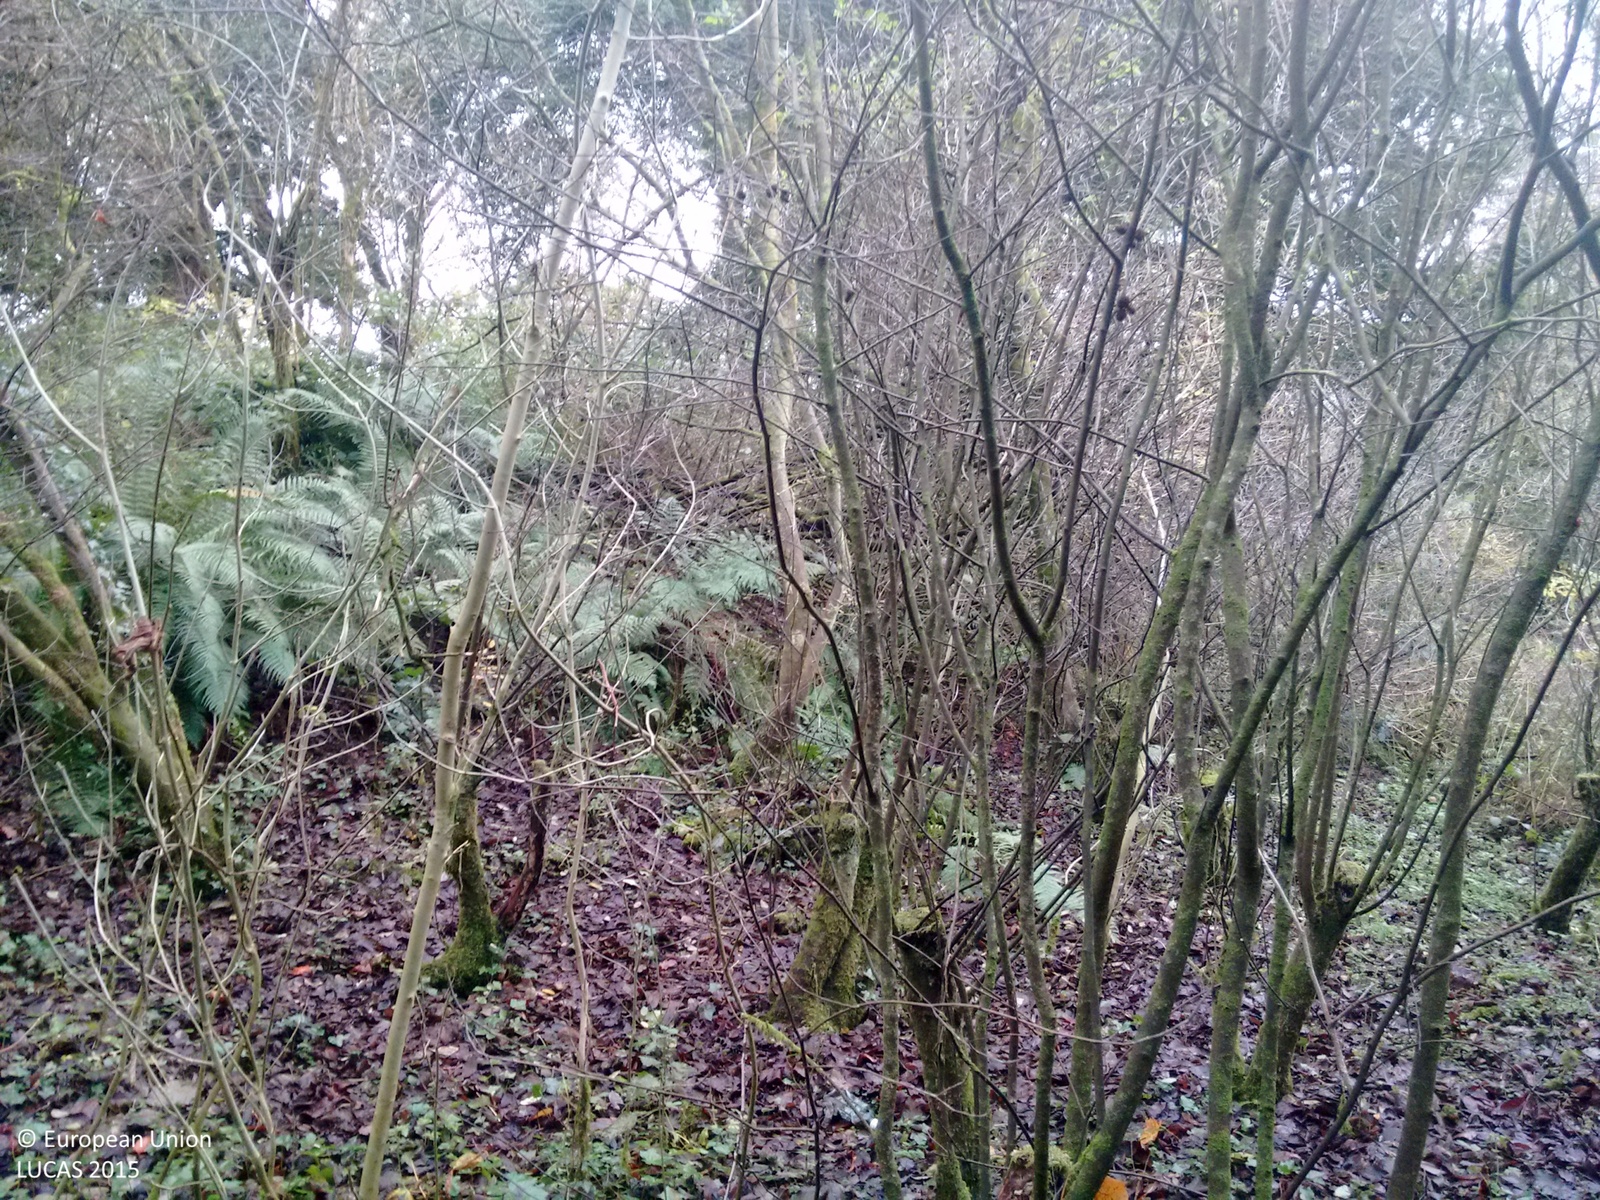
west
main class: Woodland
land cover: Other mixed woodland
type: exotic forest
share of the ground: > 75 %
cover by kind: broadleaved forest trees 60 %, coniferous forest trees 30 %, herbaceous plants 10 %
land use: Amenities, museums, leisure
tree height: > 5 m
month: November
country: GB
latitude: 54.5589
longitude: -5.9271
